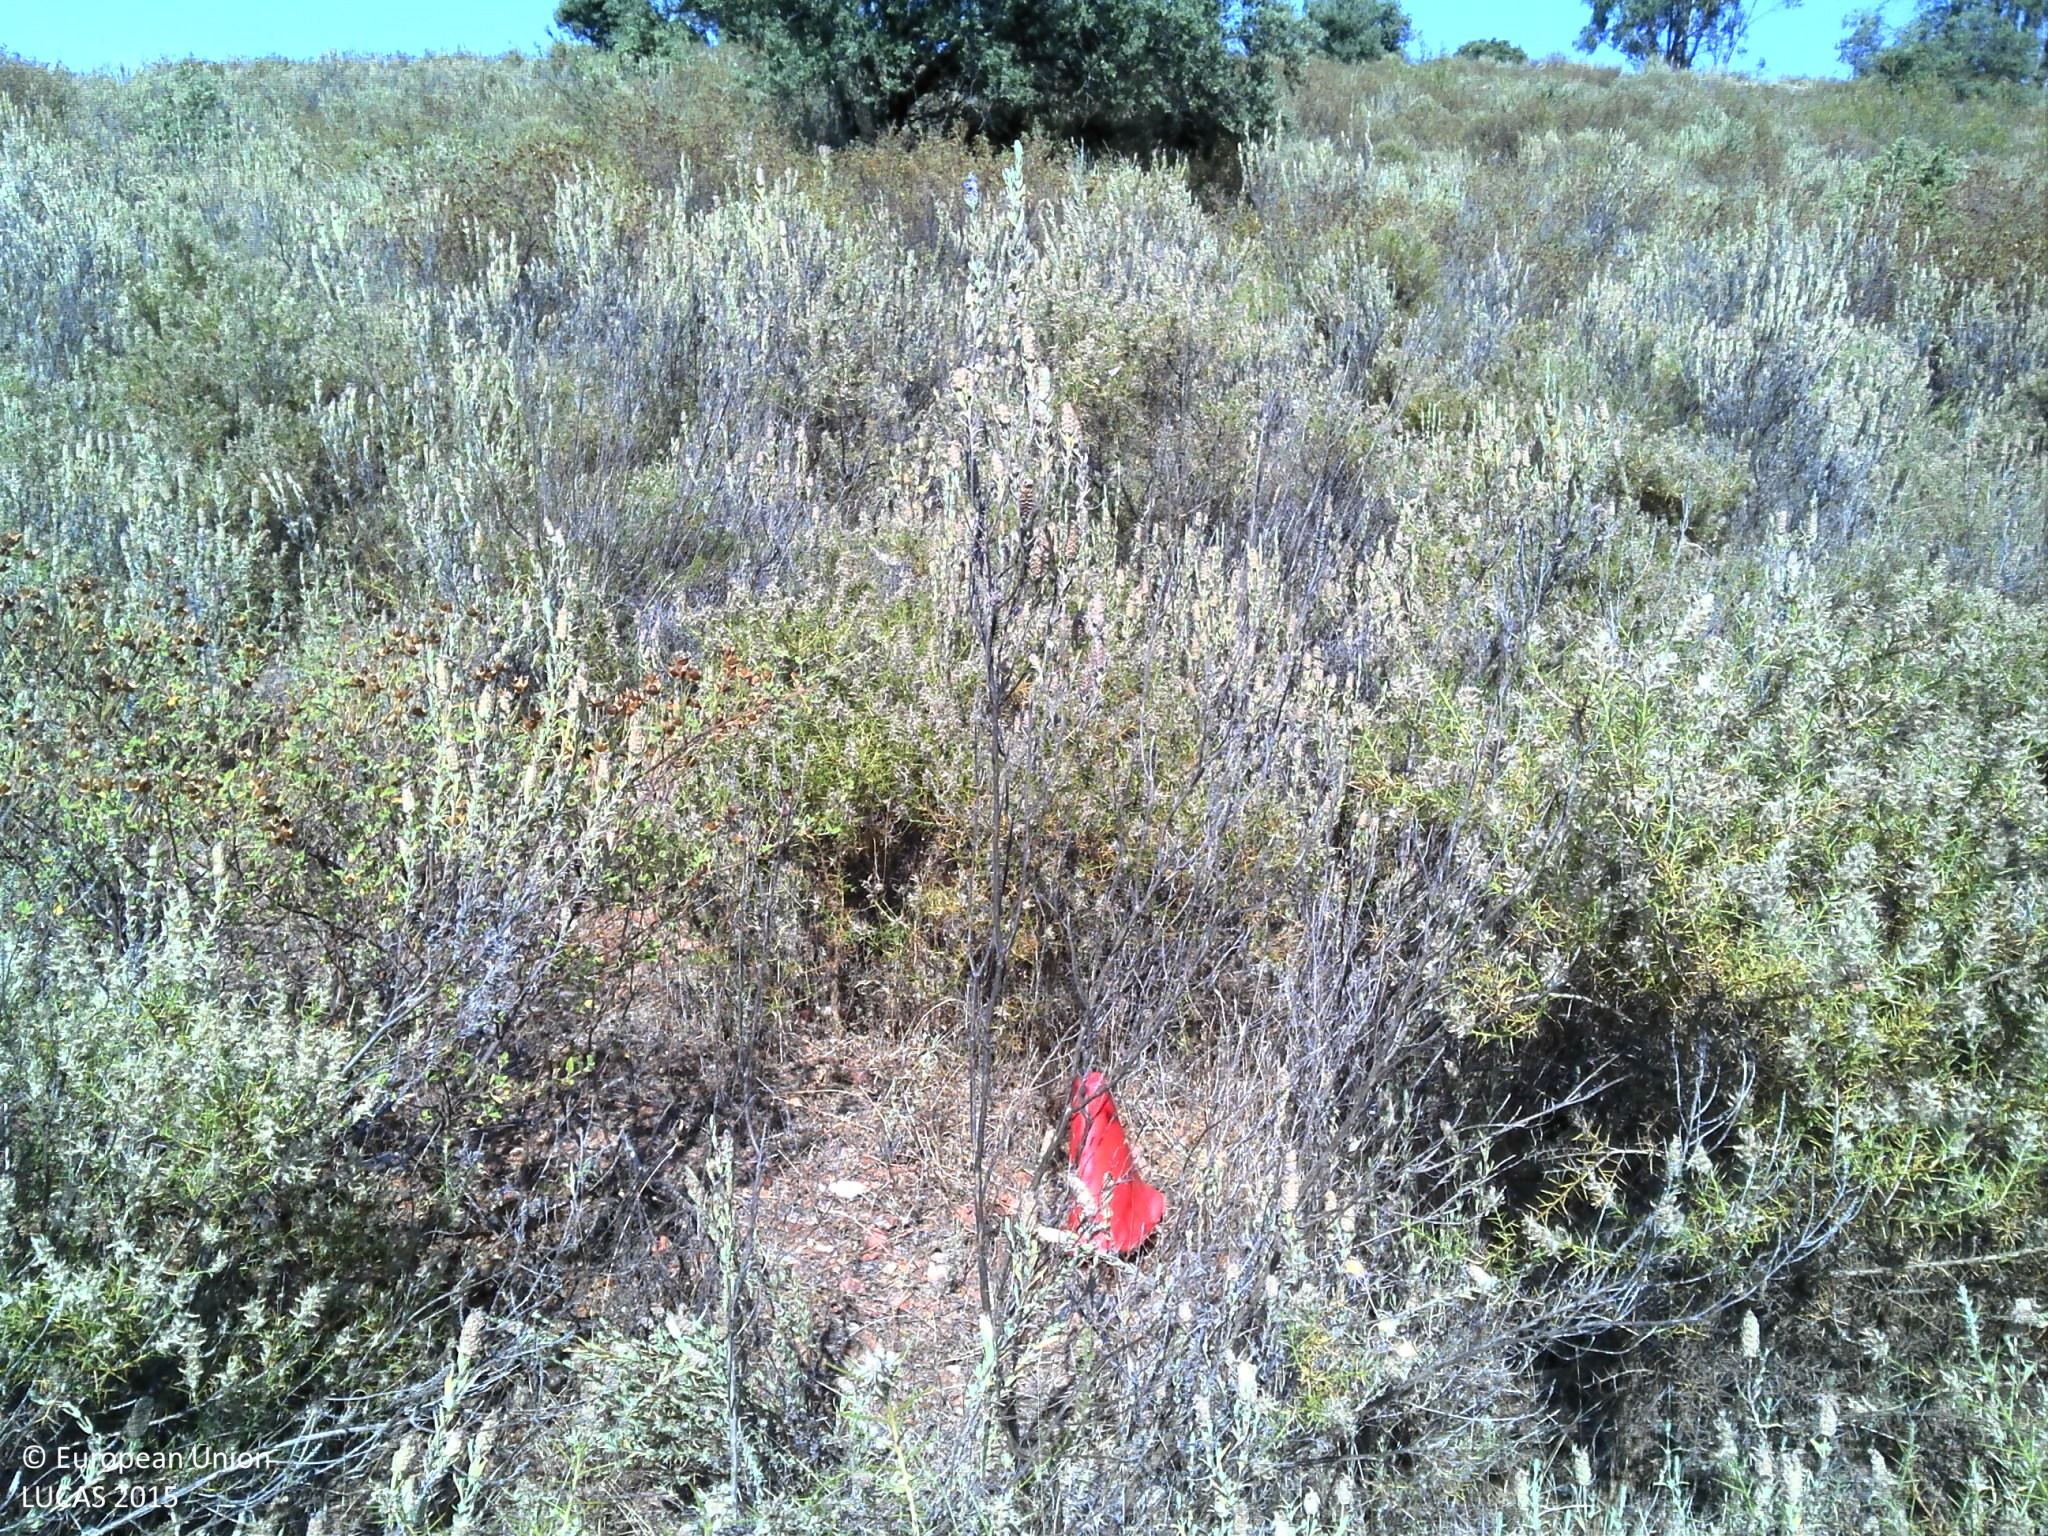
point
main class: Shrubland
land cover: Shrubland with sparse tree cover
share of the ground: > 75 %
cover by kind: shrubs 95 %, broadleaved forest trees 5 %
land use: Abandoned areas
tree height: < 5 m
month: June
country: PT
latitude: 37.7030
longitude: -7.4916
